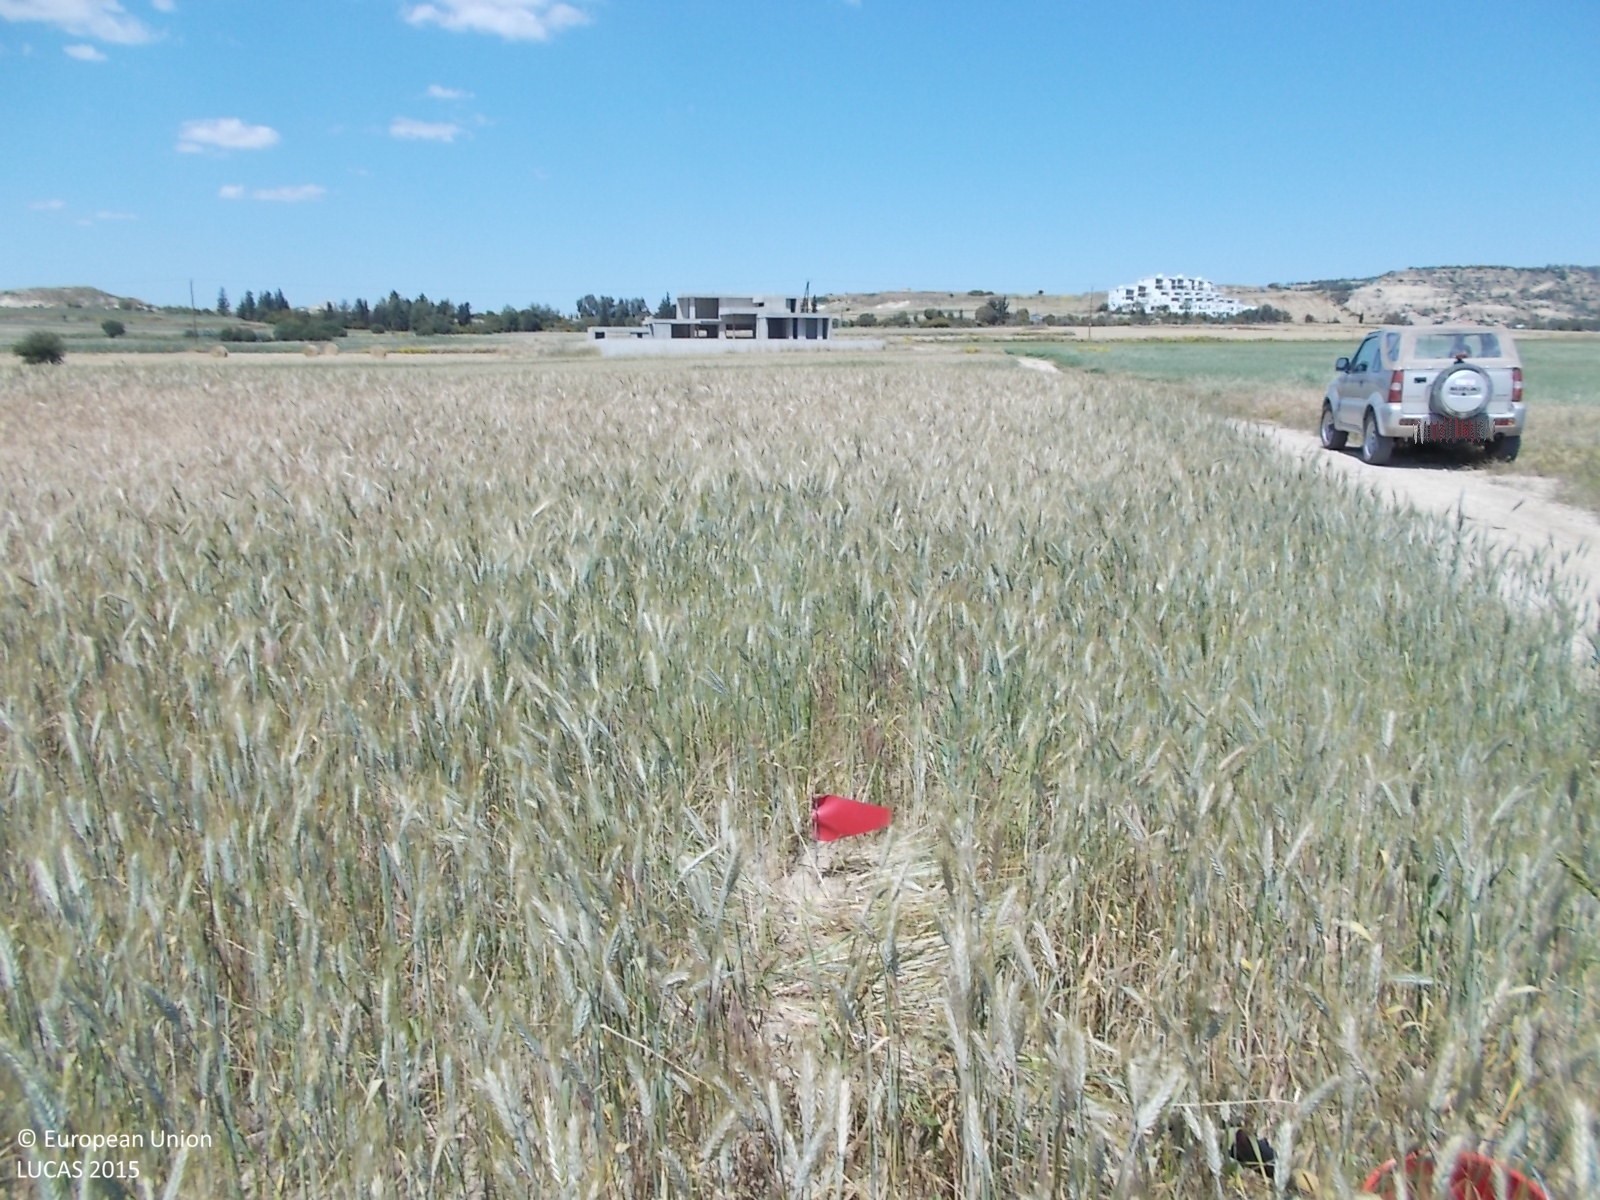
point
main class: Cropland
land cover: Common wheat
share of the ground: > 75 %
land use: Agriculture (excluding fallow land and kitchen gardens)
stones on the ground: < 10 %
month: April
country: CY
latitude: 34.9641
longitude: 33.6470
